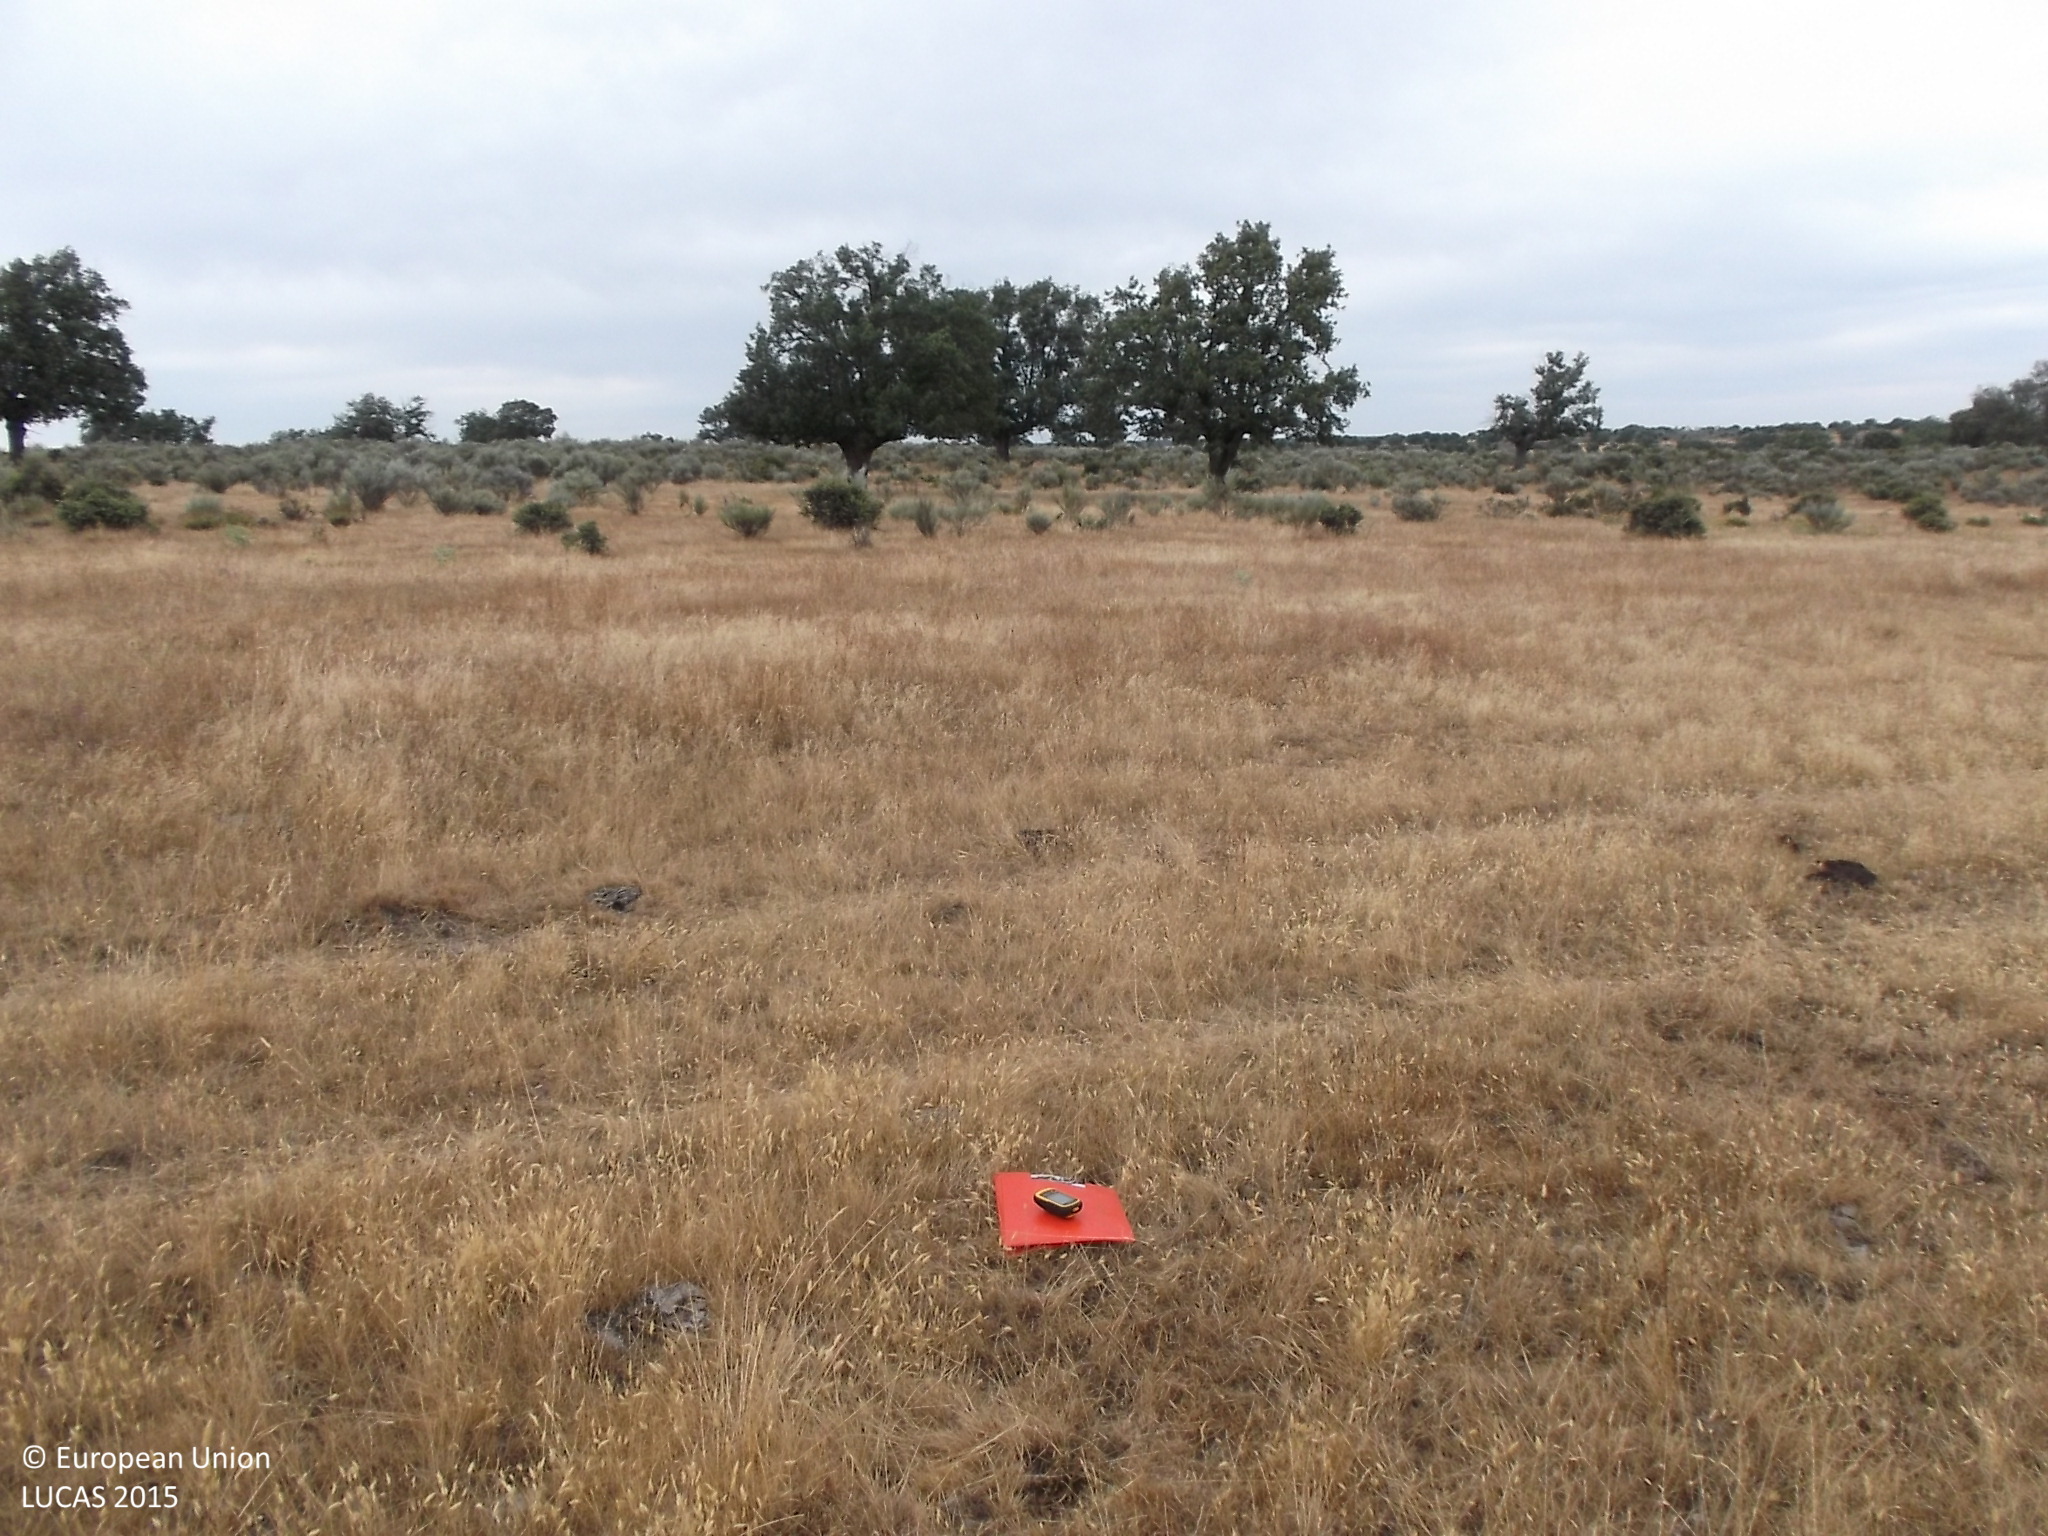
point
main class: Grassland
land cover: Grassland without tree/shrub cover
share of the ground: > 75 %
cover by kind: herbaceous plants 100 %
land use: Agriculture (excluding fallow land and kitchen gardens)
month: July
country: ES
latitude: 41.0619
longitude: -6.4329
